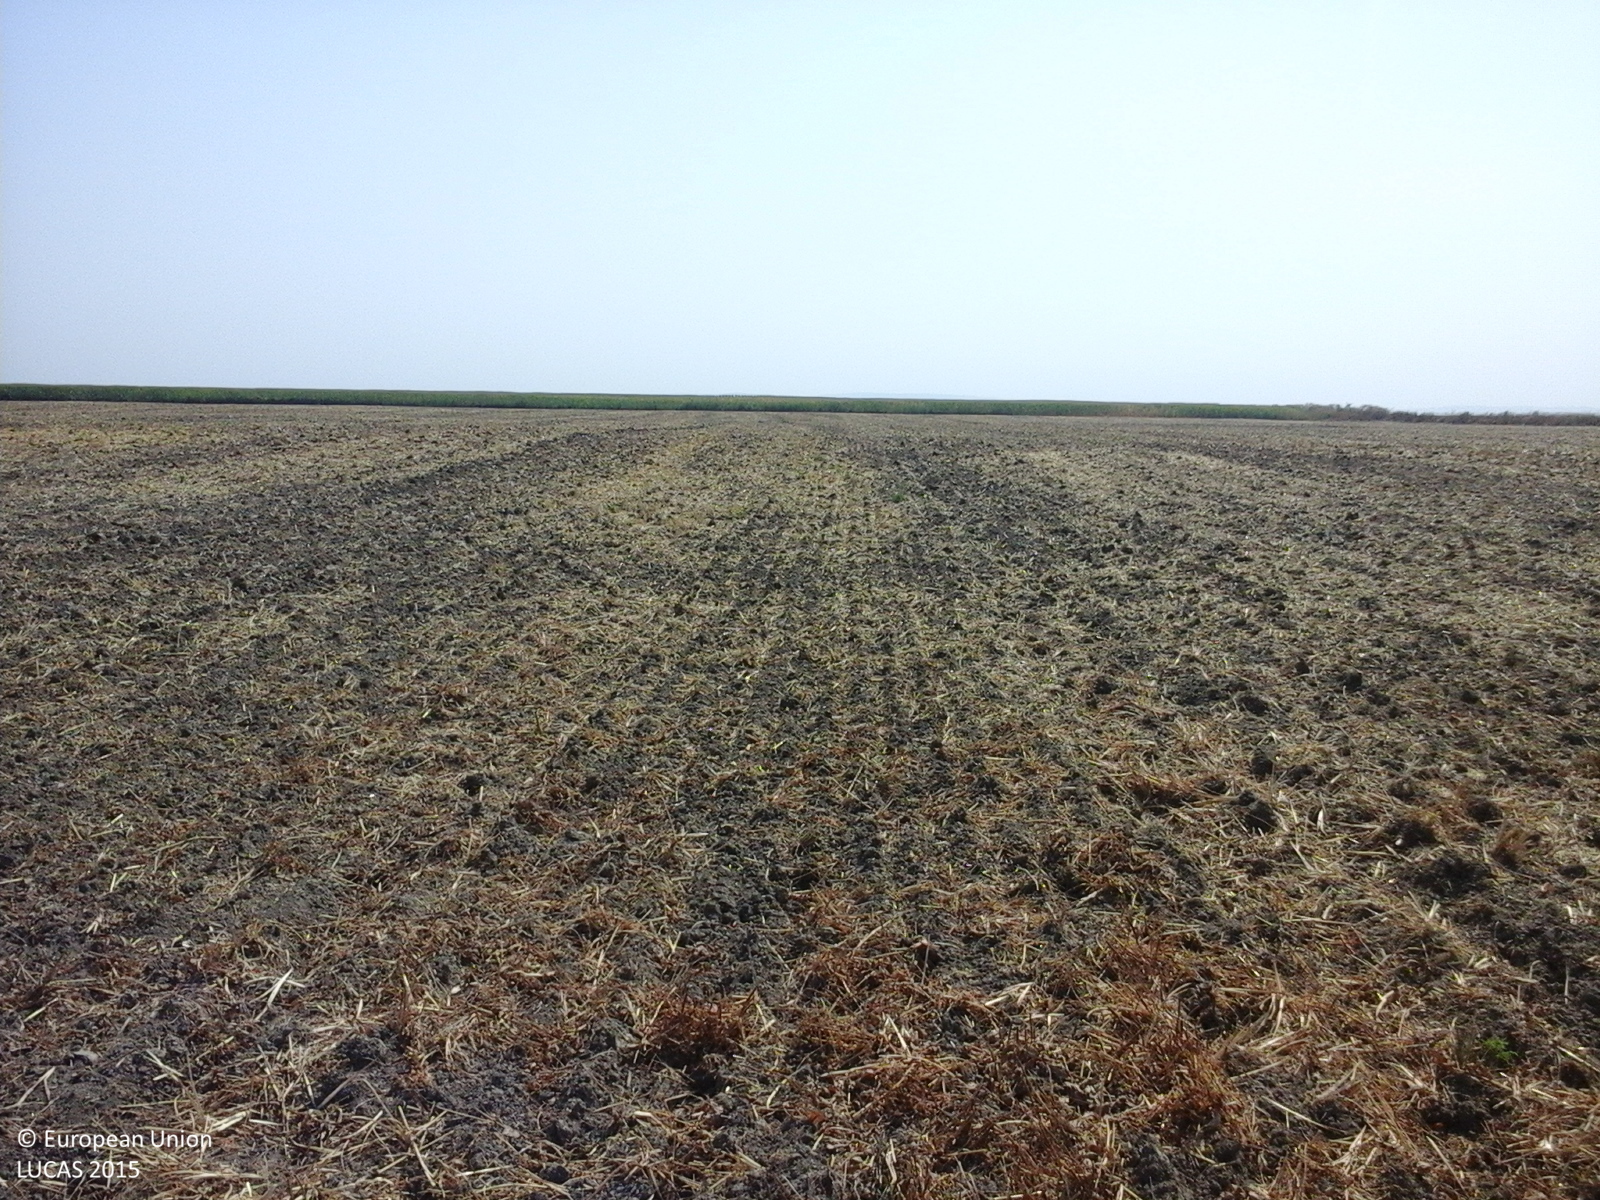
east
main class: Cropland
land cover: Common wheat
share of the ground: < 10 %
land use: Agriculture (excluding fallow land and kitchen gardens)
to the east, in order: Common wheat
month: August
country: RO
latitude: 44.9773
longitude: 27.9793
